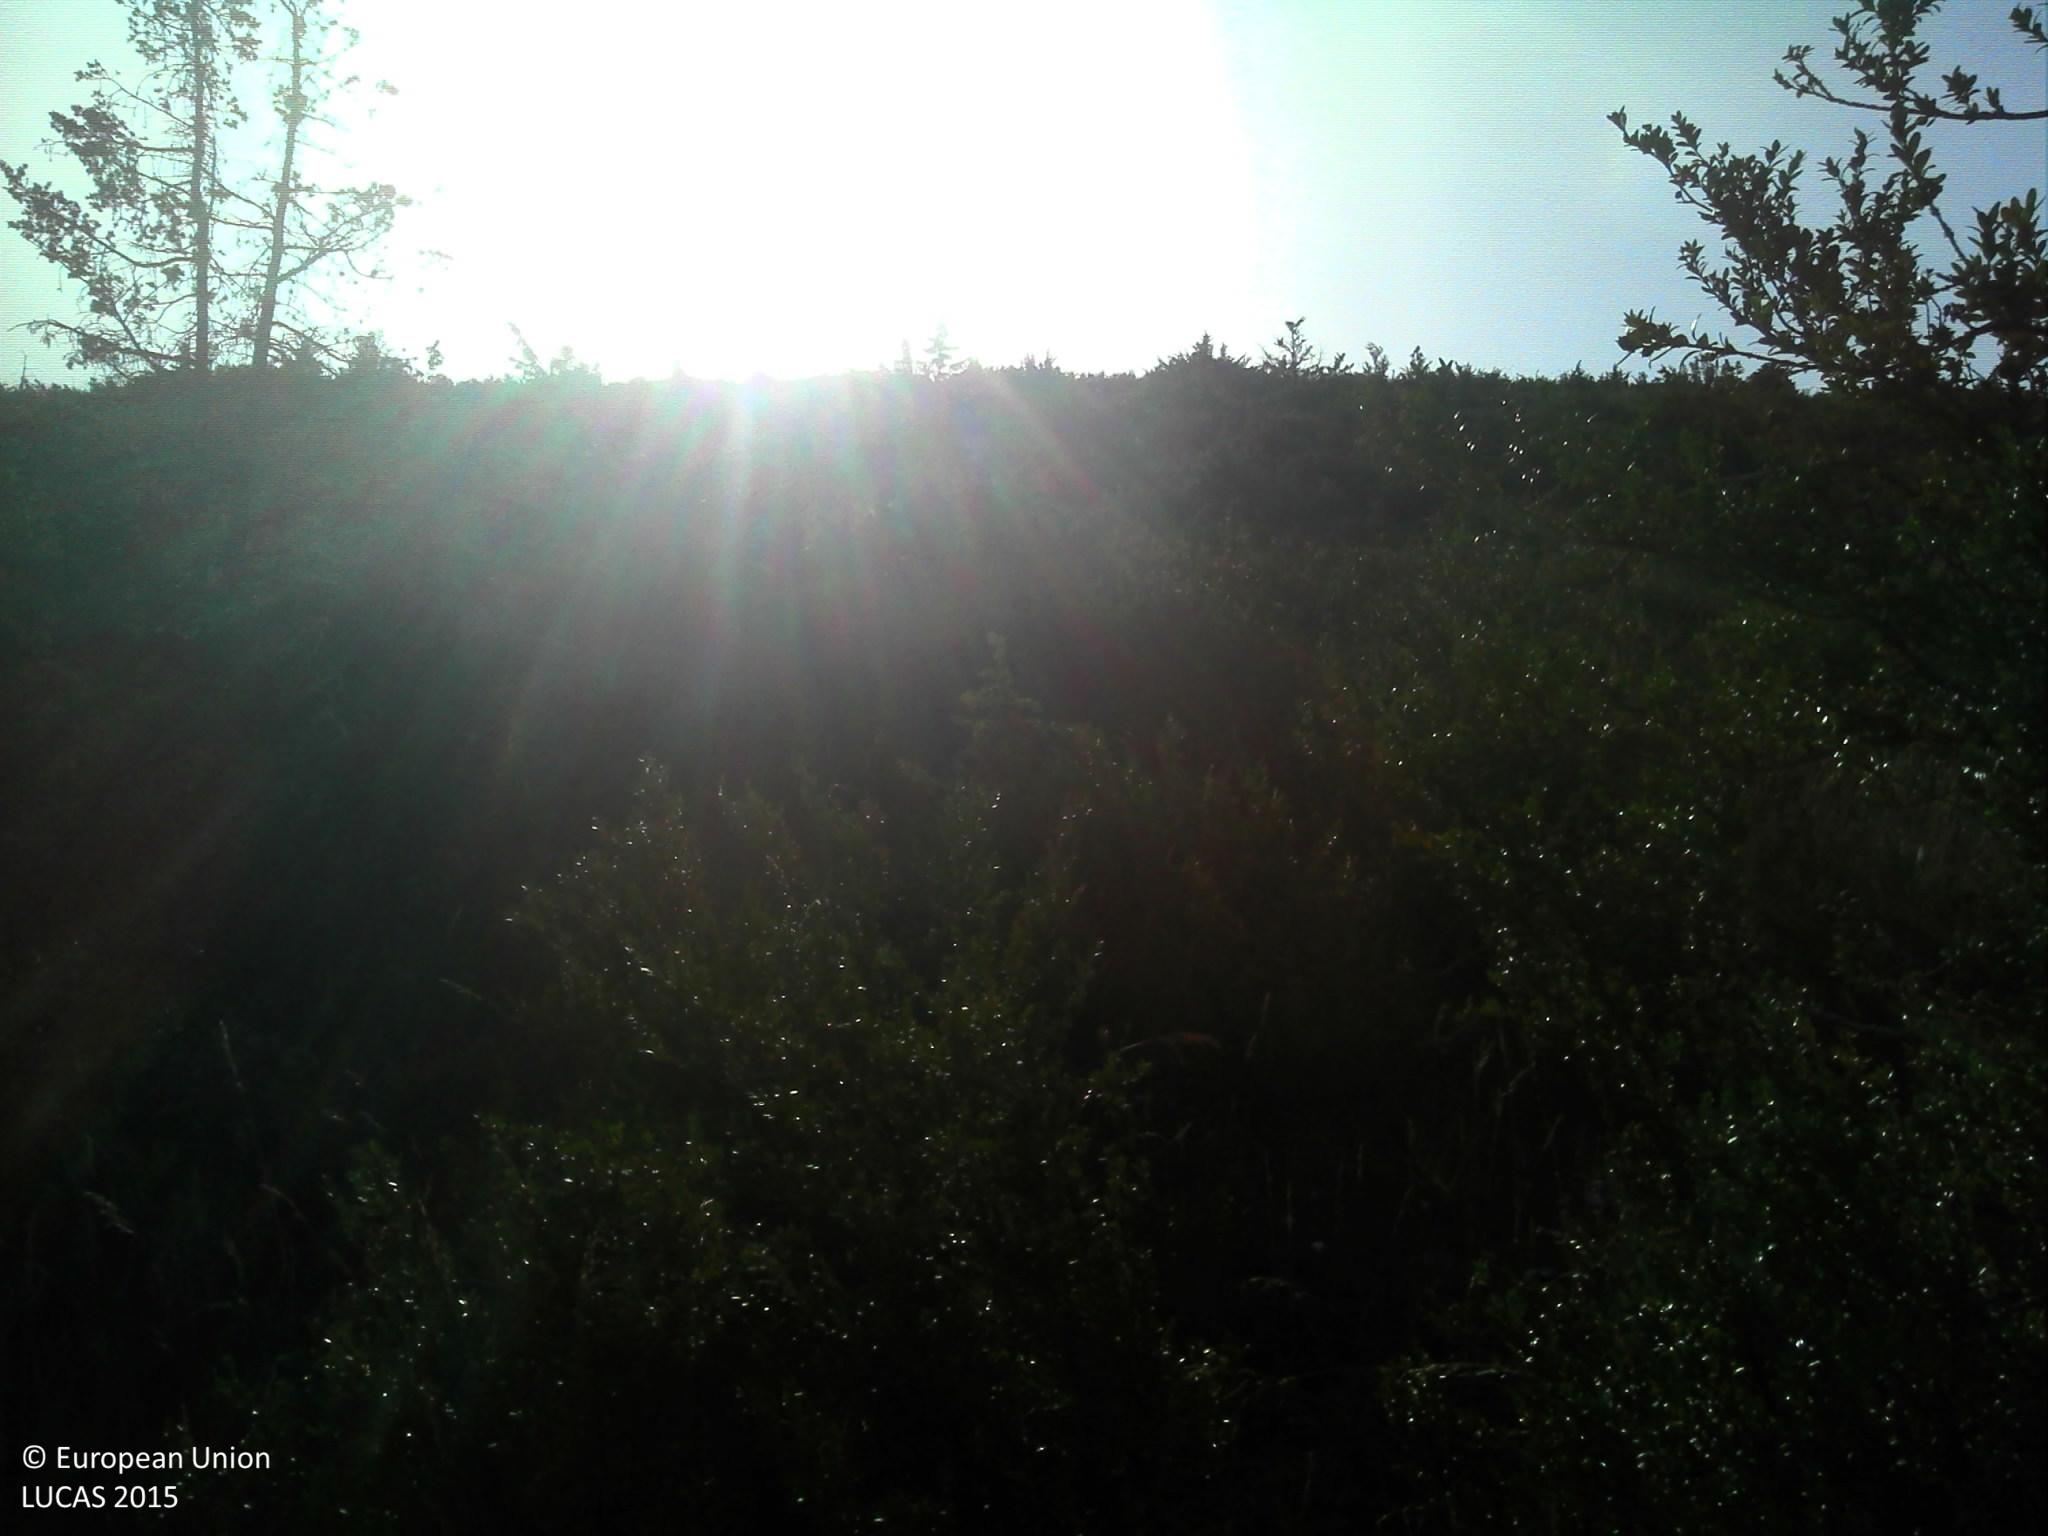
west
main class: Shrubland
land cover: Shrubland with sparse tree cover
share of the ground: > 75 %
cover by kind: shrubs 45 %, herbaceous plants 45 %, coniferous forest trees 5 %
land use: Semi-natural and natural areas not in use
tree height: < 5 m
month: July
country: FR
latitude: 44.3306
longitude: 3.5475
